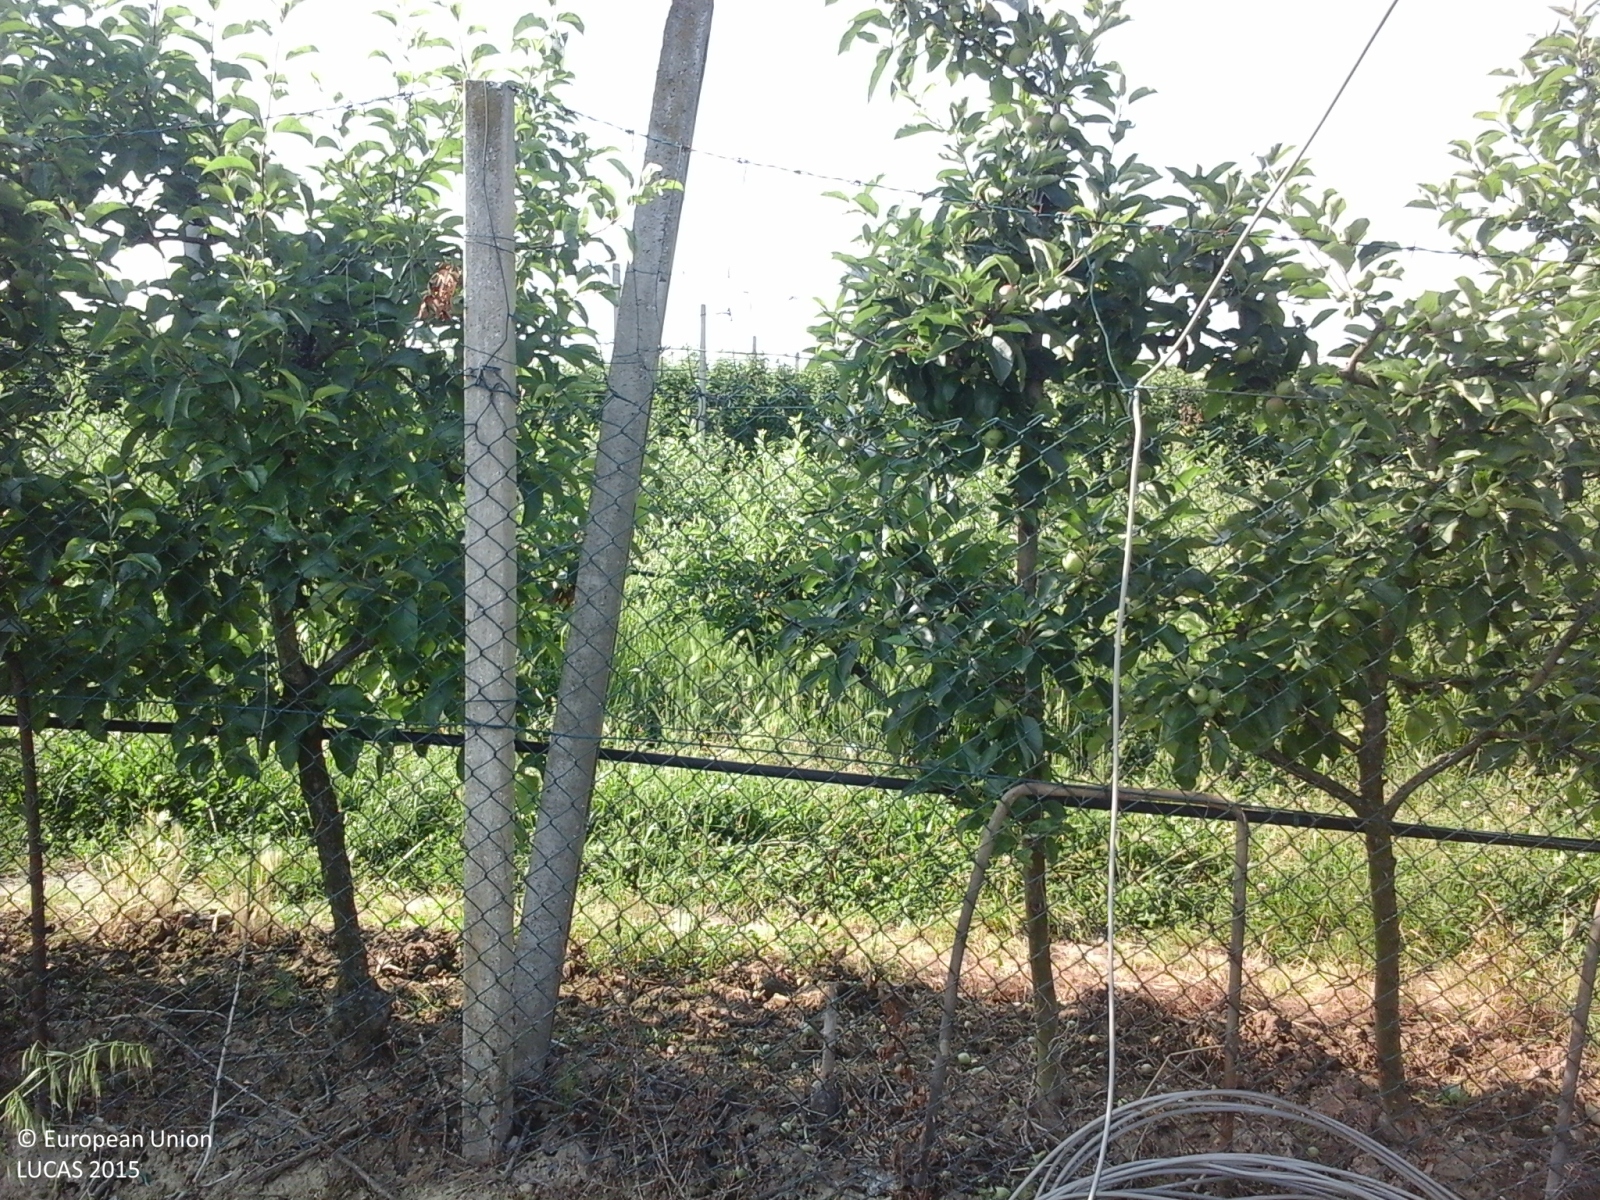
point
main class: Cropland
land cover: Apple fruit
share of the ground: 25 - 50 %
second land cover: Grassland without tree/shrub cover
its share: > 75 %
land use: Agriculture (excluding fallow land and kitchen gardens)
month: May
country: IT
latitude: 45.2475
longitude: 10.9793
